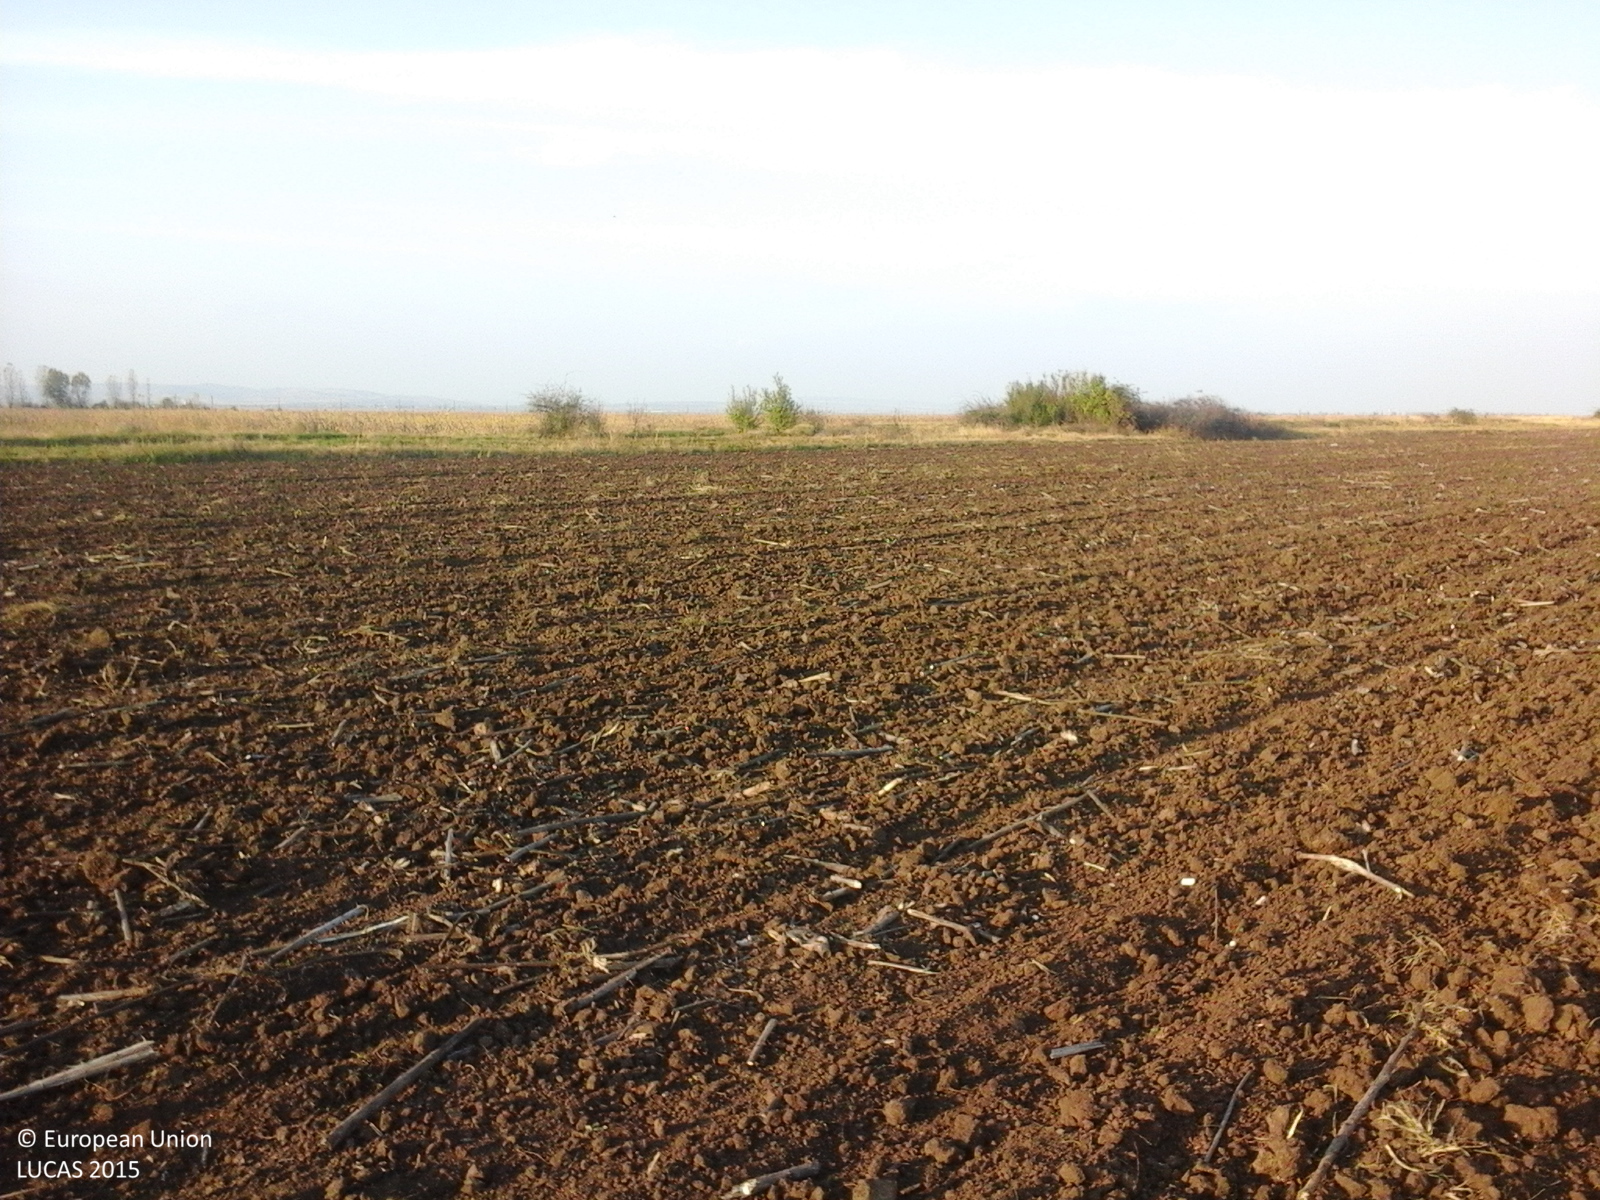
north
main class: Cropland
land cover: Sunflower
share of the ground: < 10 %
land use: Agriculture (excluding fallow land and kitchen gardens)
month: October
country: RO
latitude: 45.1574
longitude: 26.9120
